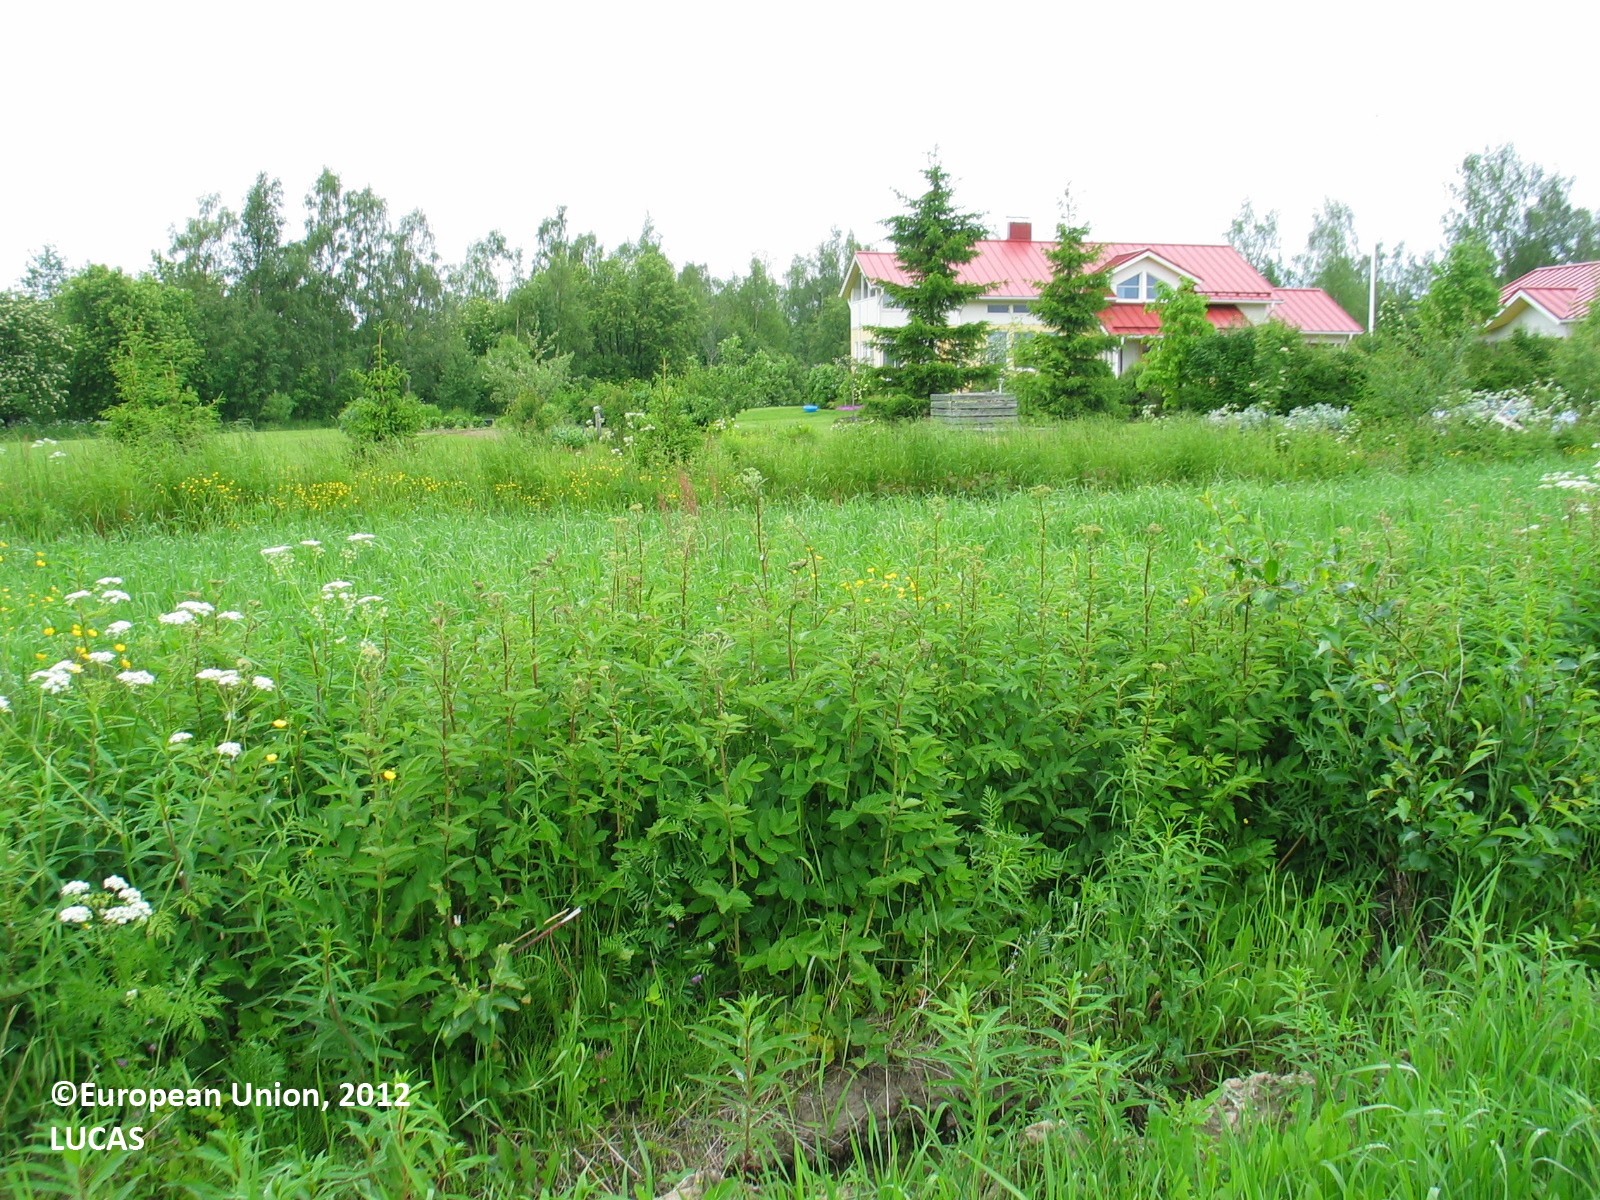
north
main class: Grassland
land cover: Grassland without tree/shrub cover
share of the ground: 25 - 50 %
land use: Agriculture (excluding fallow land and kitchen gardens)
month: June
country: FI
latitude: 65.1233
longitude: 25.3547
